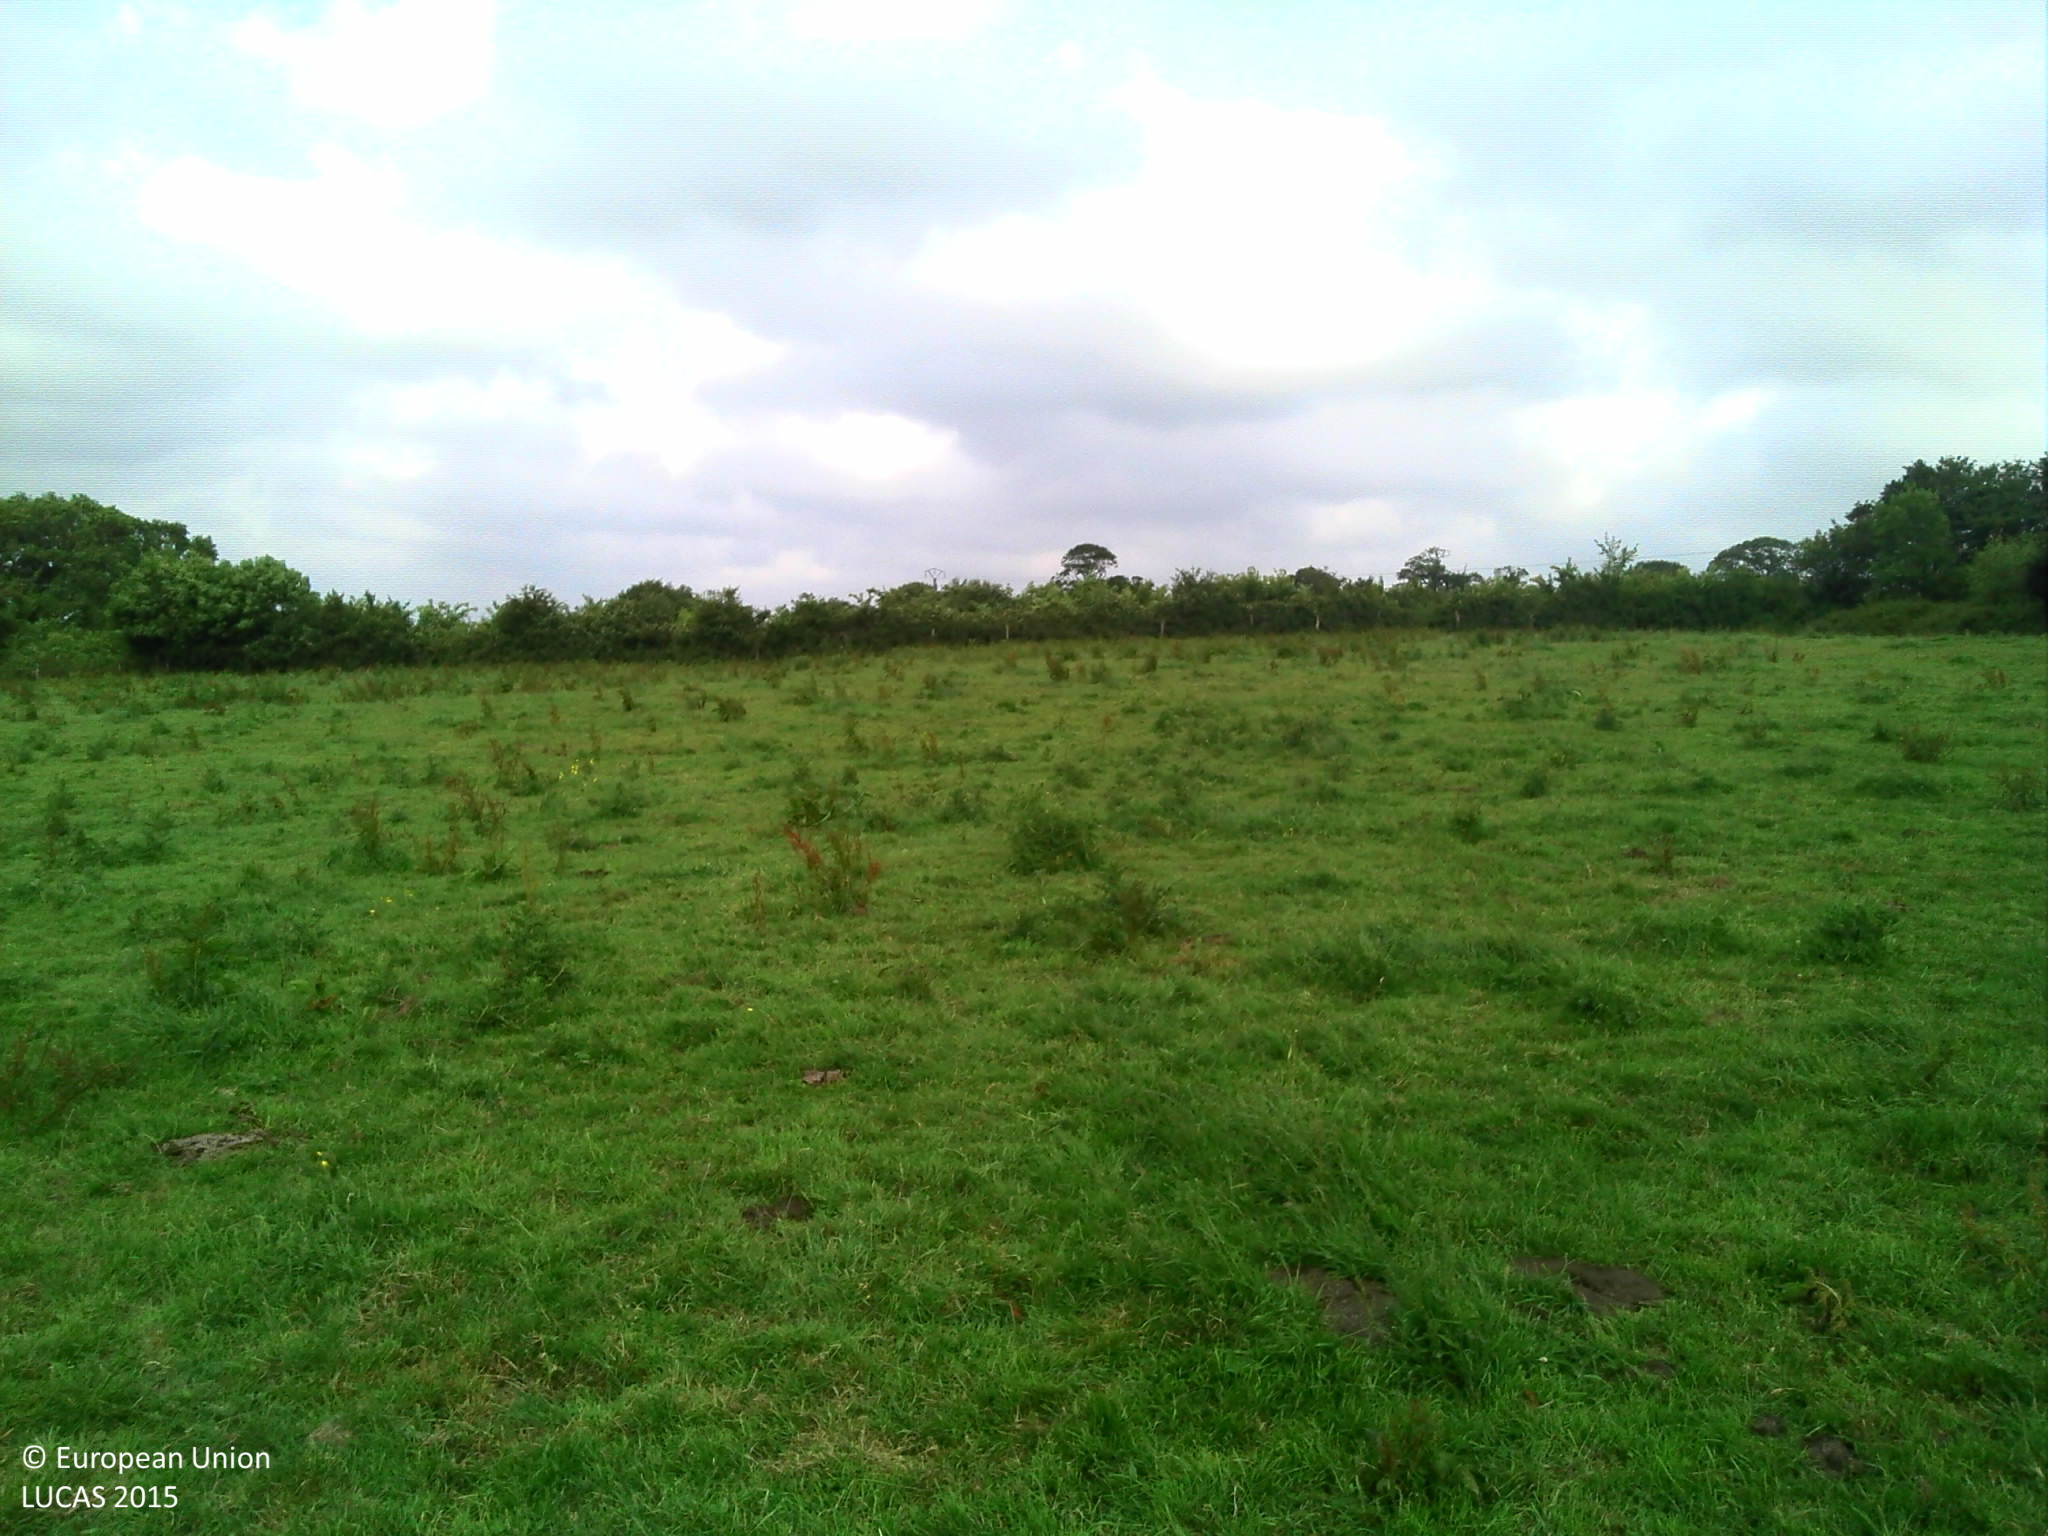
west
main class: Grassland
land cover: Grassland without tree/shrub cover
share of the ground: > 75 %
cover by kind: herbaceous plants 95 %, shrubs 5 %
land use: Agriculture (excluding fallow land and kitchen gardens)
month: June
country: FR
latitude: 49.5356
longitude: -1.4207
